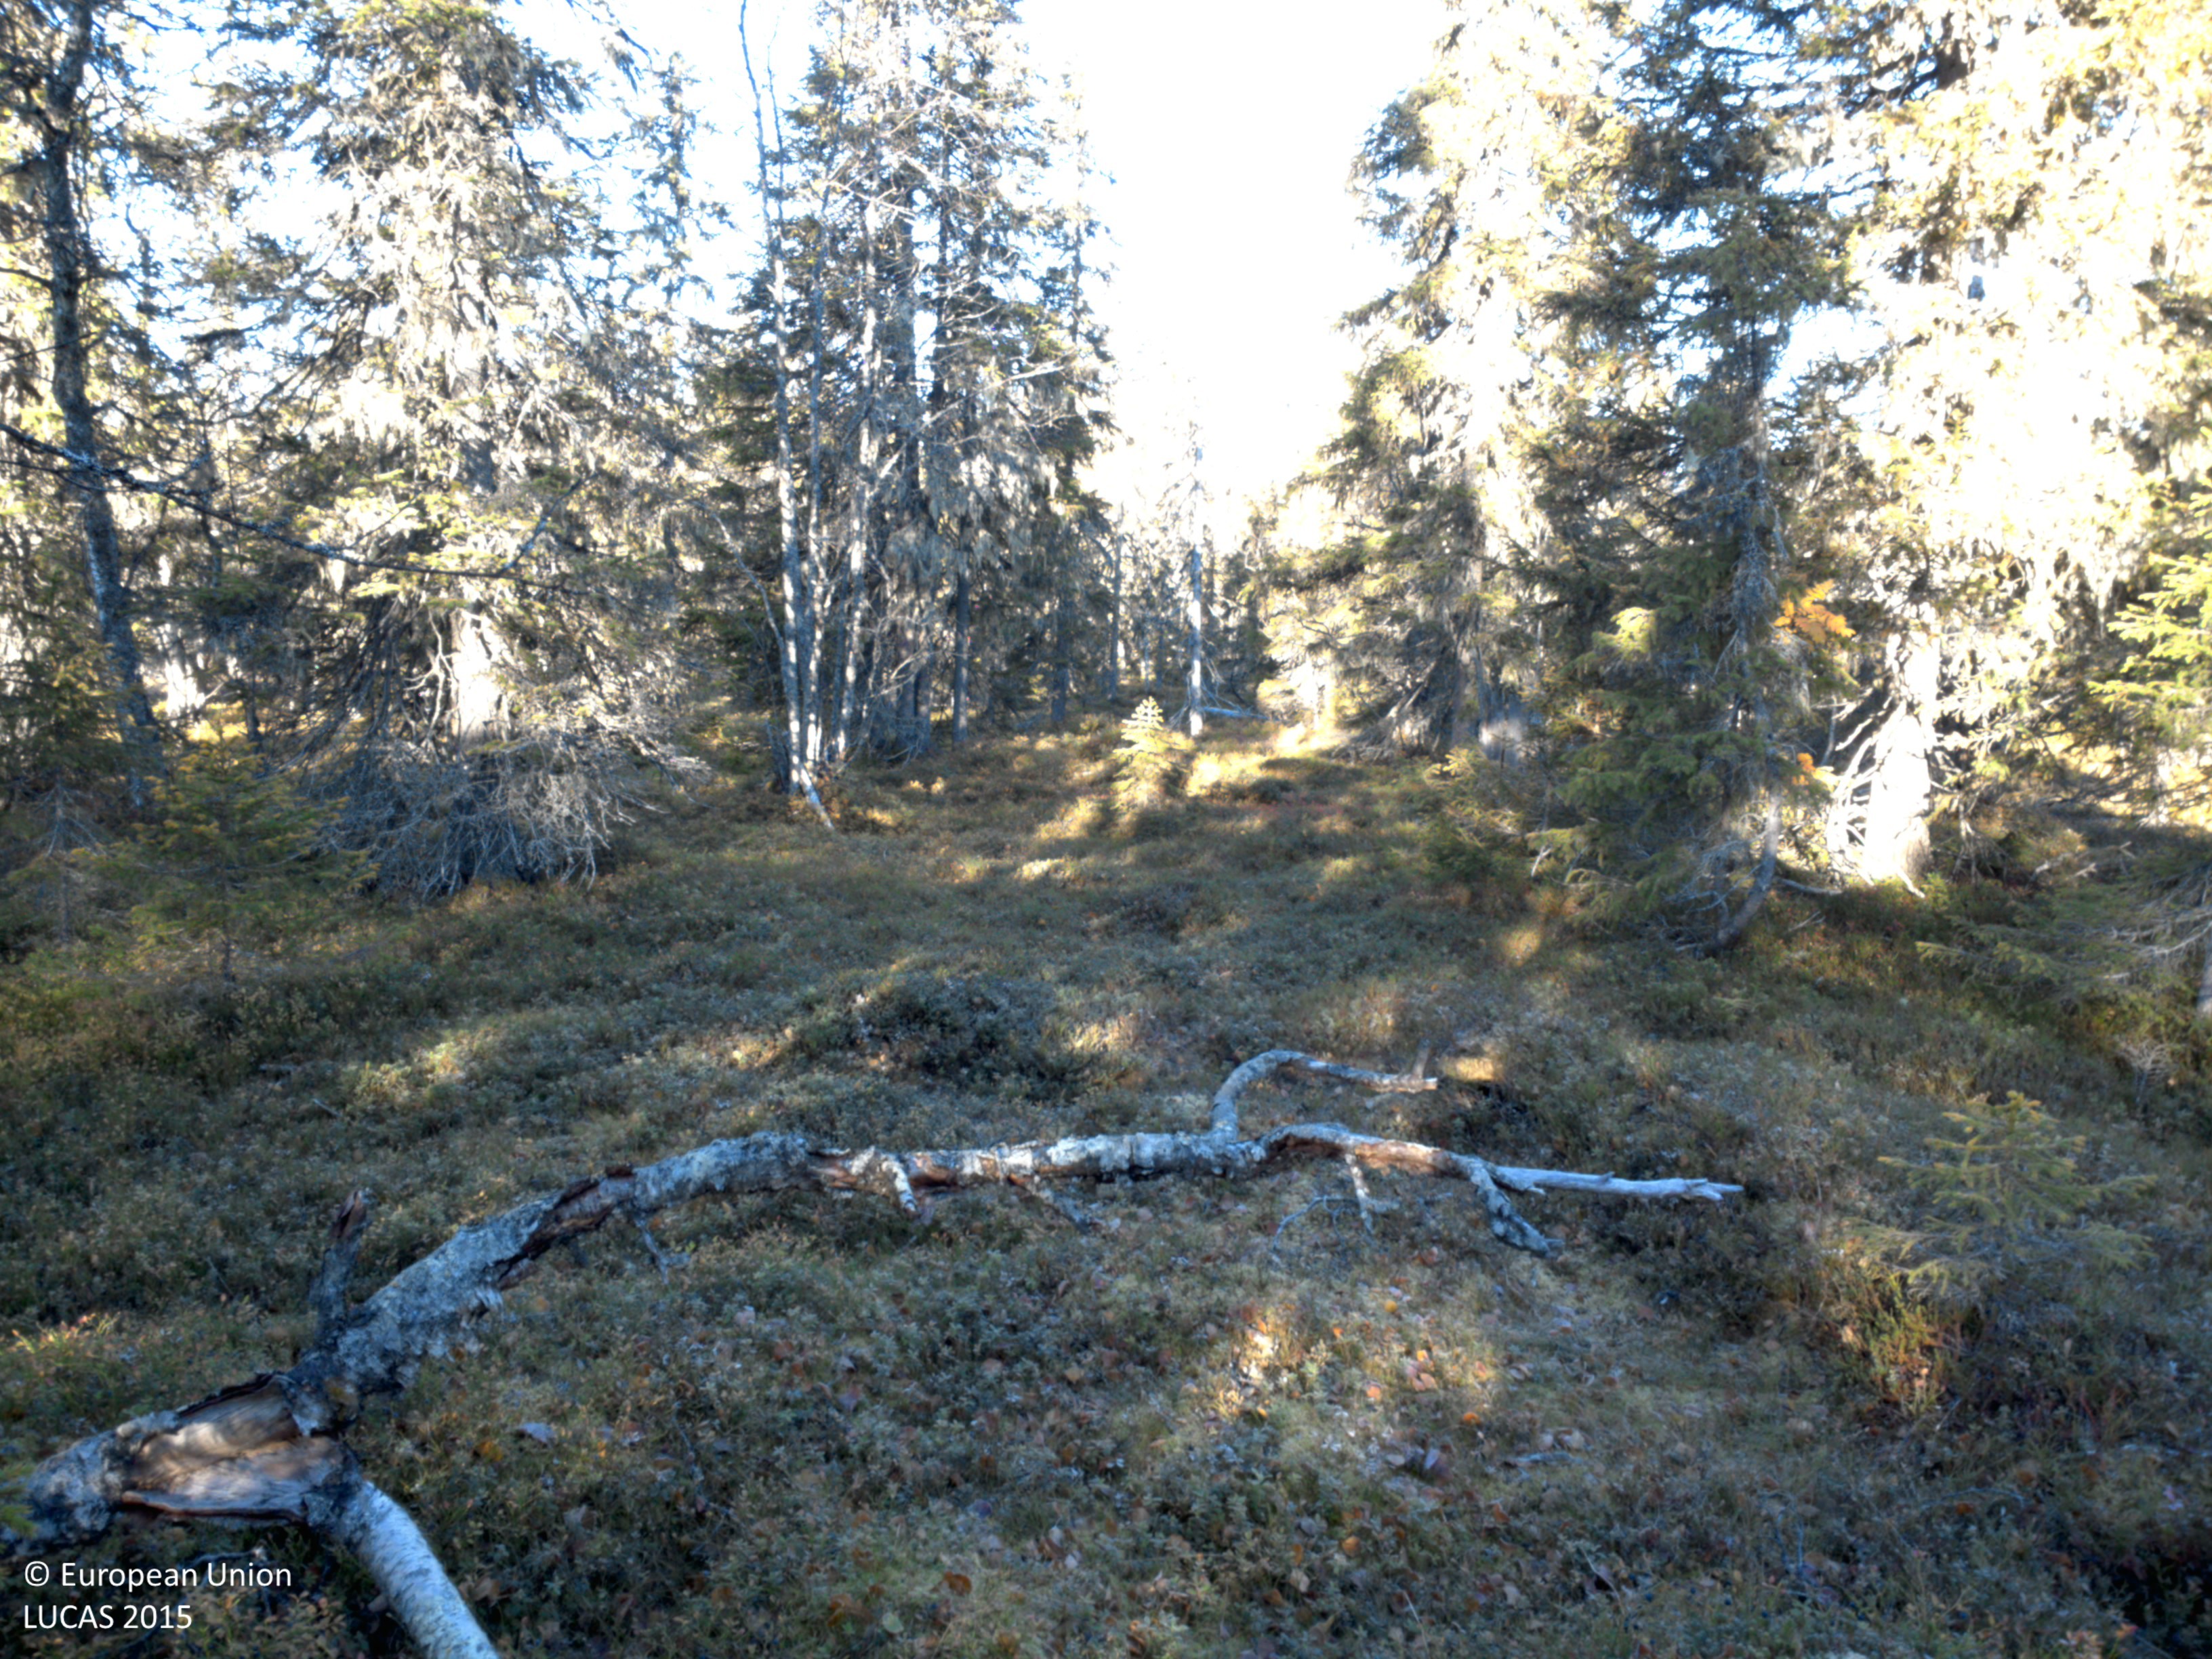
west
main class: Woodland
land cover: Spruce dominated mixed woodland
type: boreal forest
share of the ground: 25 - 50 %
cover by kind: coniferous forest trees 35 %, shrubs 30 %, broadleaved forest trees 15 %, lichens and mosses 15 %, herbaceous plants 5 %
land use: Forestry
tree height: > 5 m
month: October
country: SE
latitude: 64.5518
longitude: 17.7887
